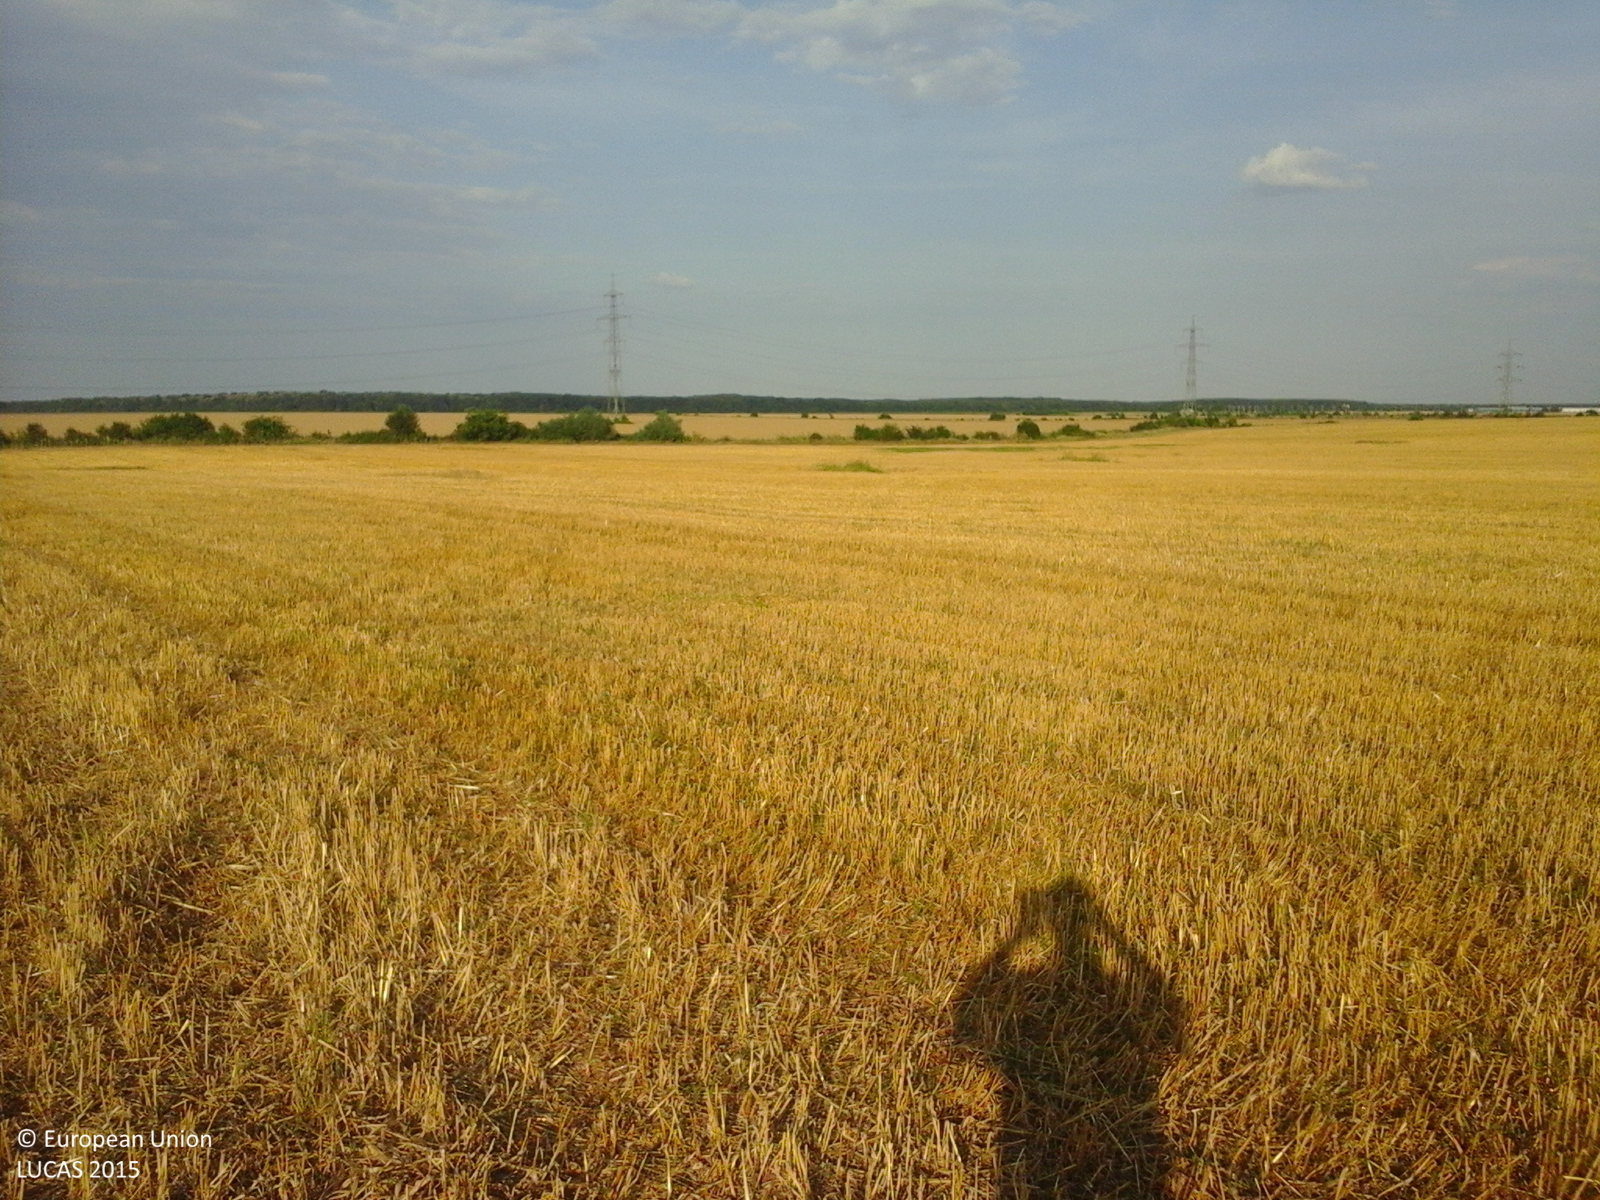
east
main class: Cropland
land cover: Common wheat
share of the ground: < 10 %
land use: Agriculture (excluding fallow land and kitchen gardens)
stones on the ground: < 10 %
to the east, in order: Common wheat; Spontaneously vegetated surfaces; Ditches and canals; Abandoned hedges; Ditches and canals
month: June
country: RO
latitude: 44.4755
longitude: 26.2384
